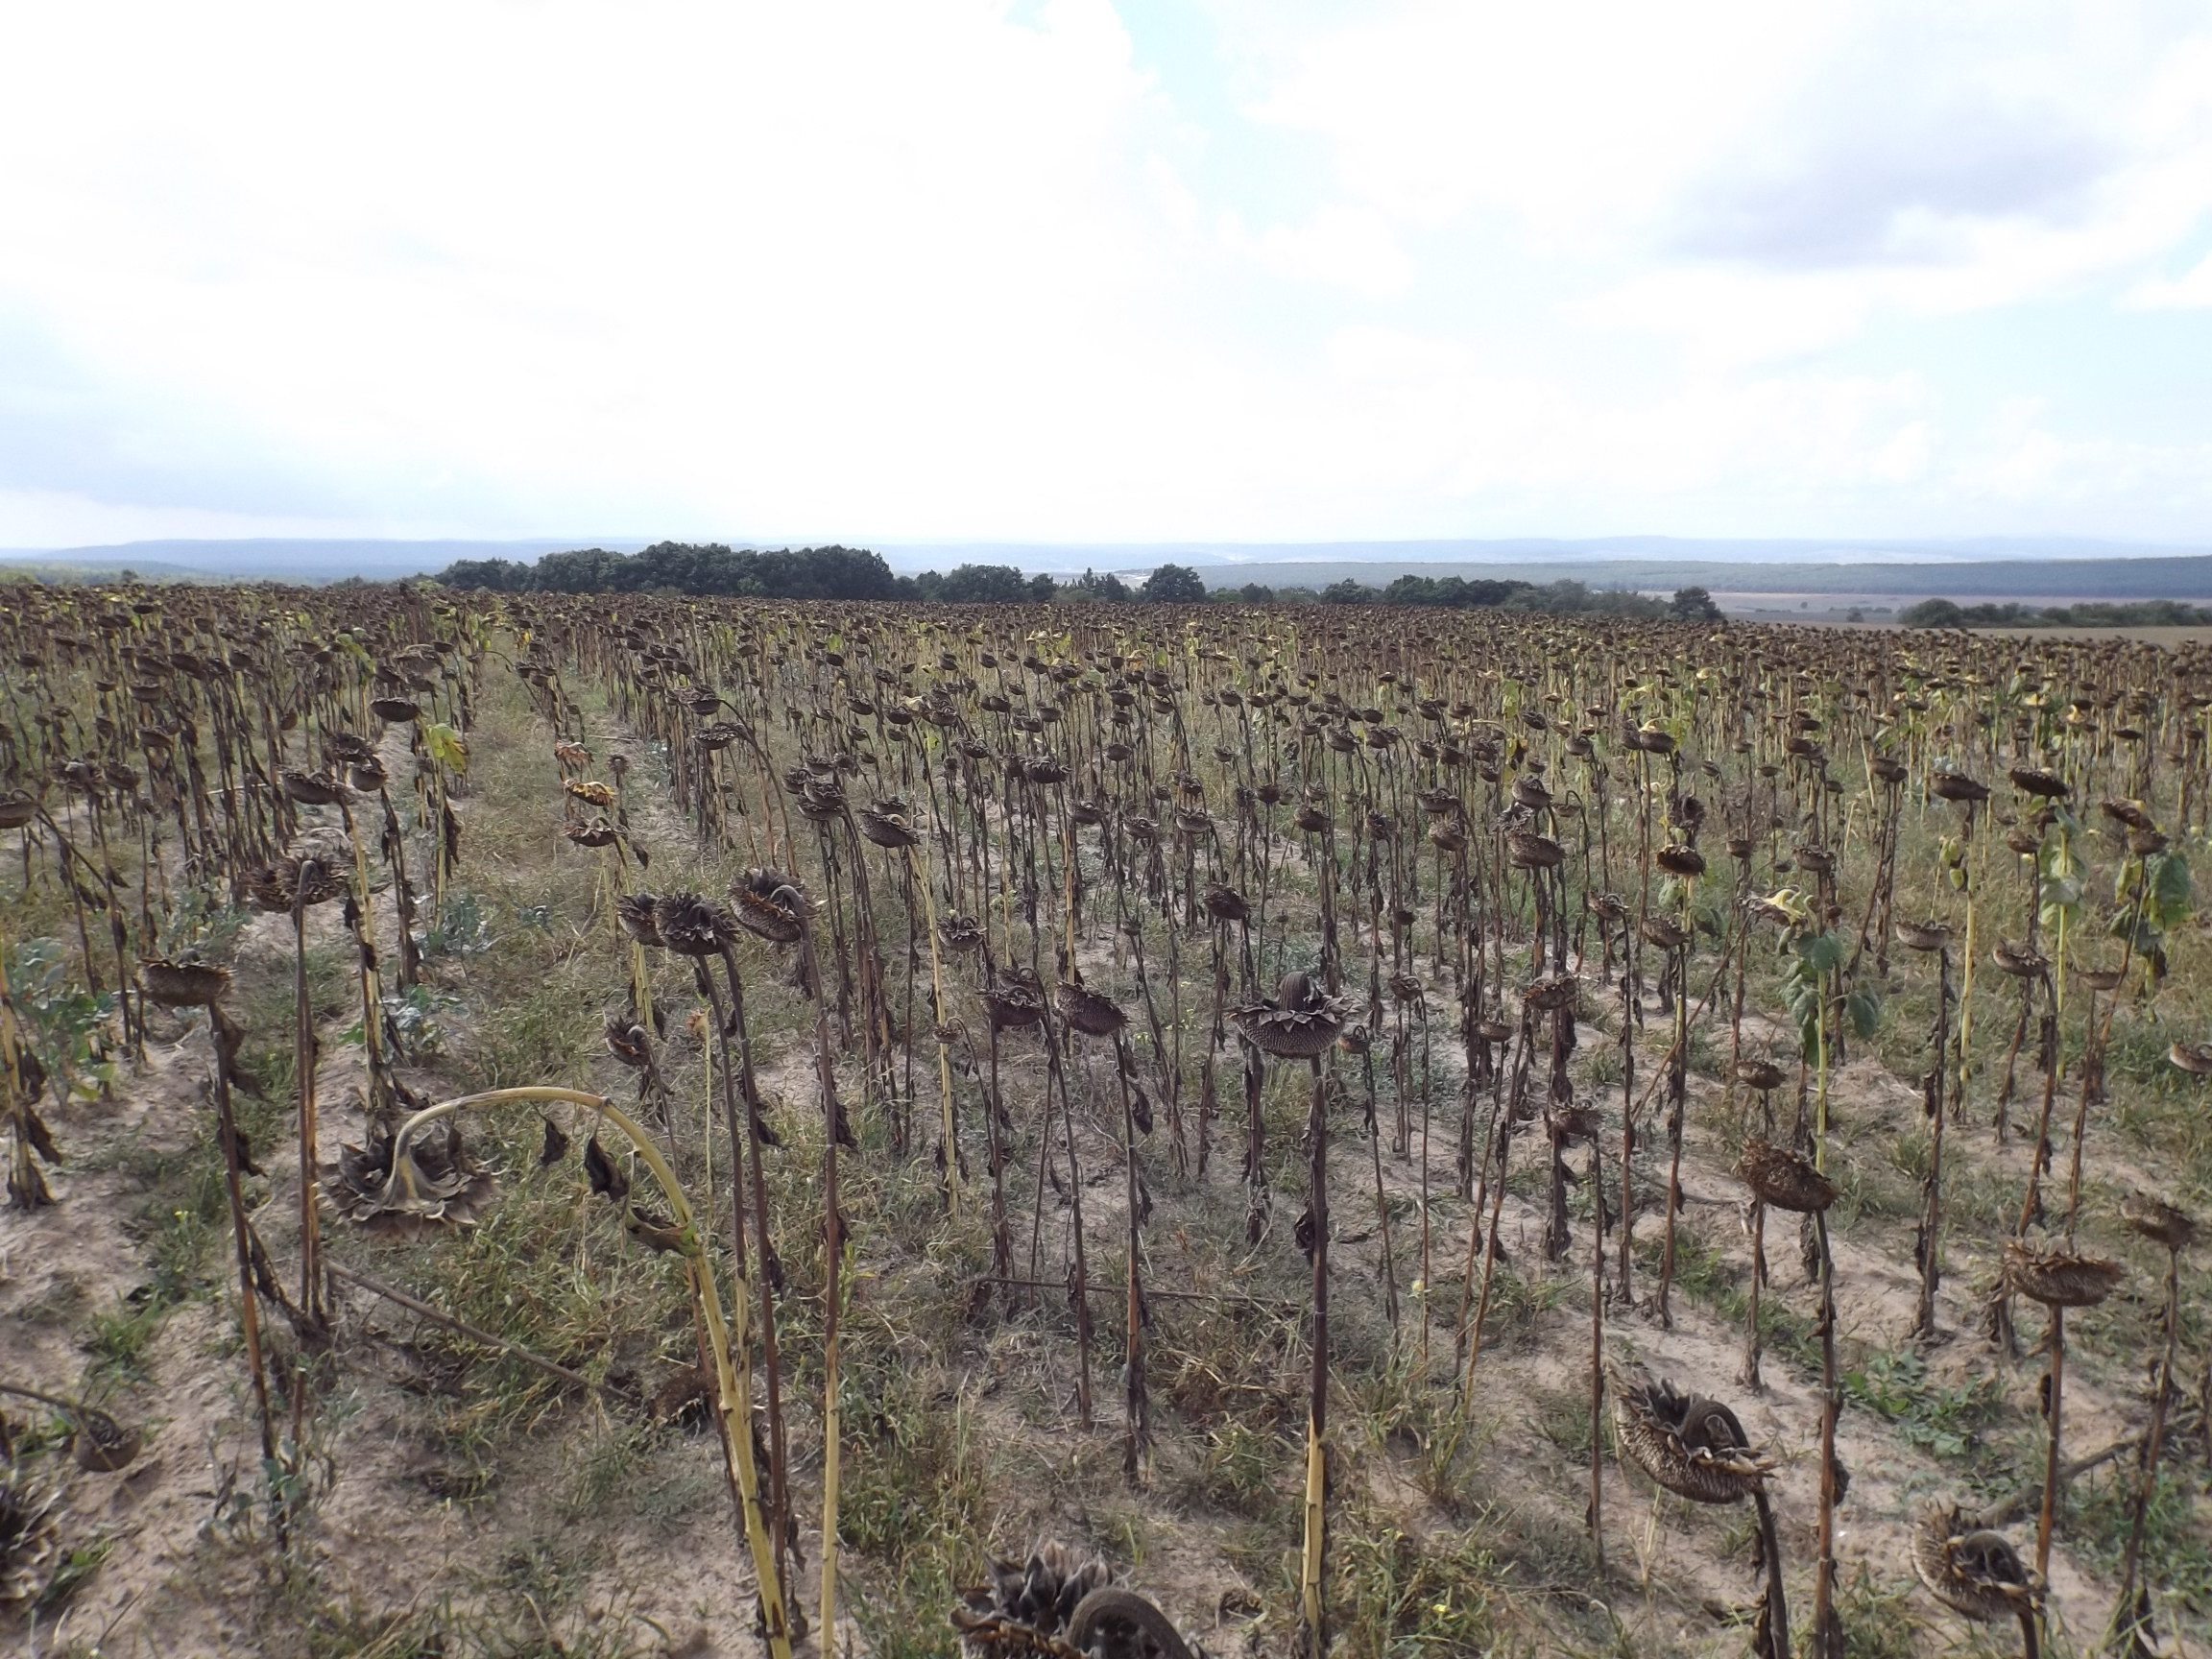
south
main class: Cropland
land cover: Sunflower
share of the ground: 25 - 50 %
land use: Agriculture (excluding fallow land and kitchen gardens)
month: September
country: BG
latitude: 43.0632
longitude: 27.8545
